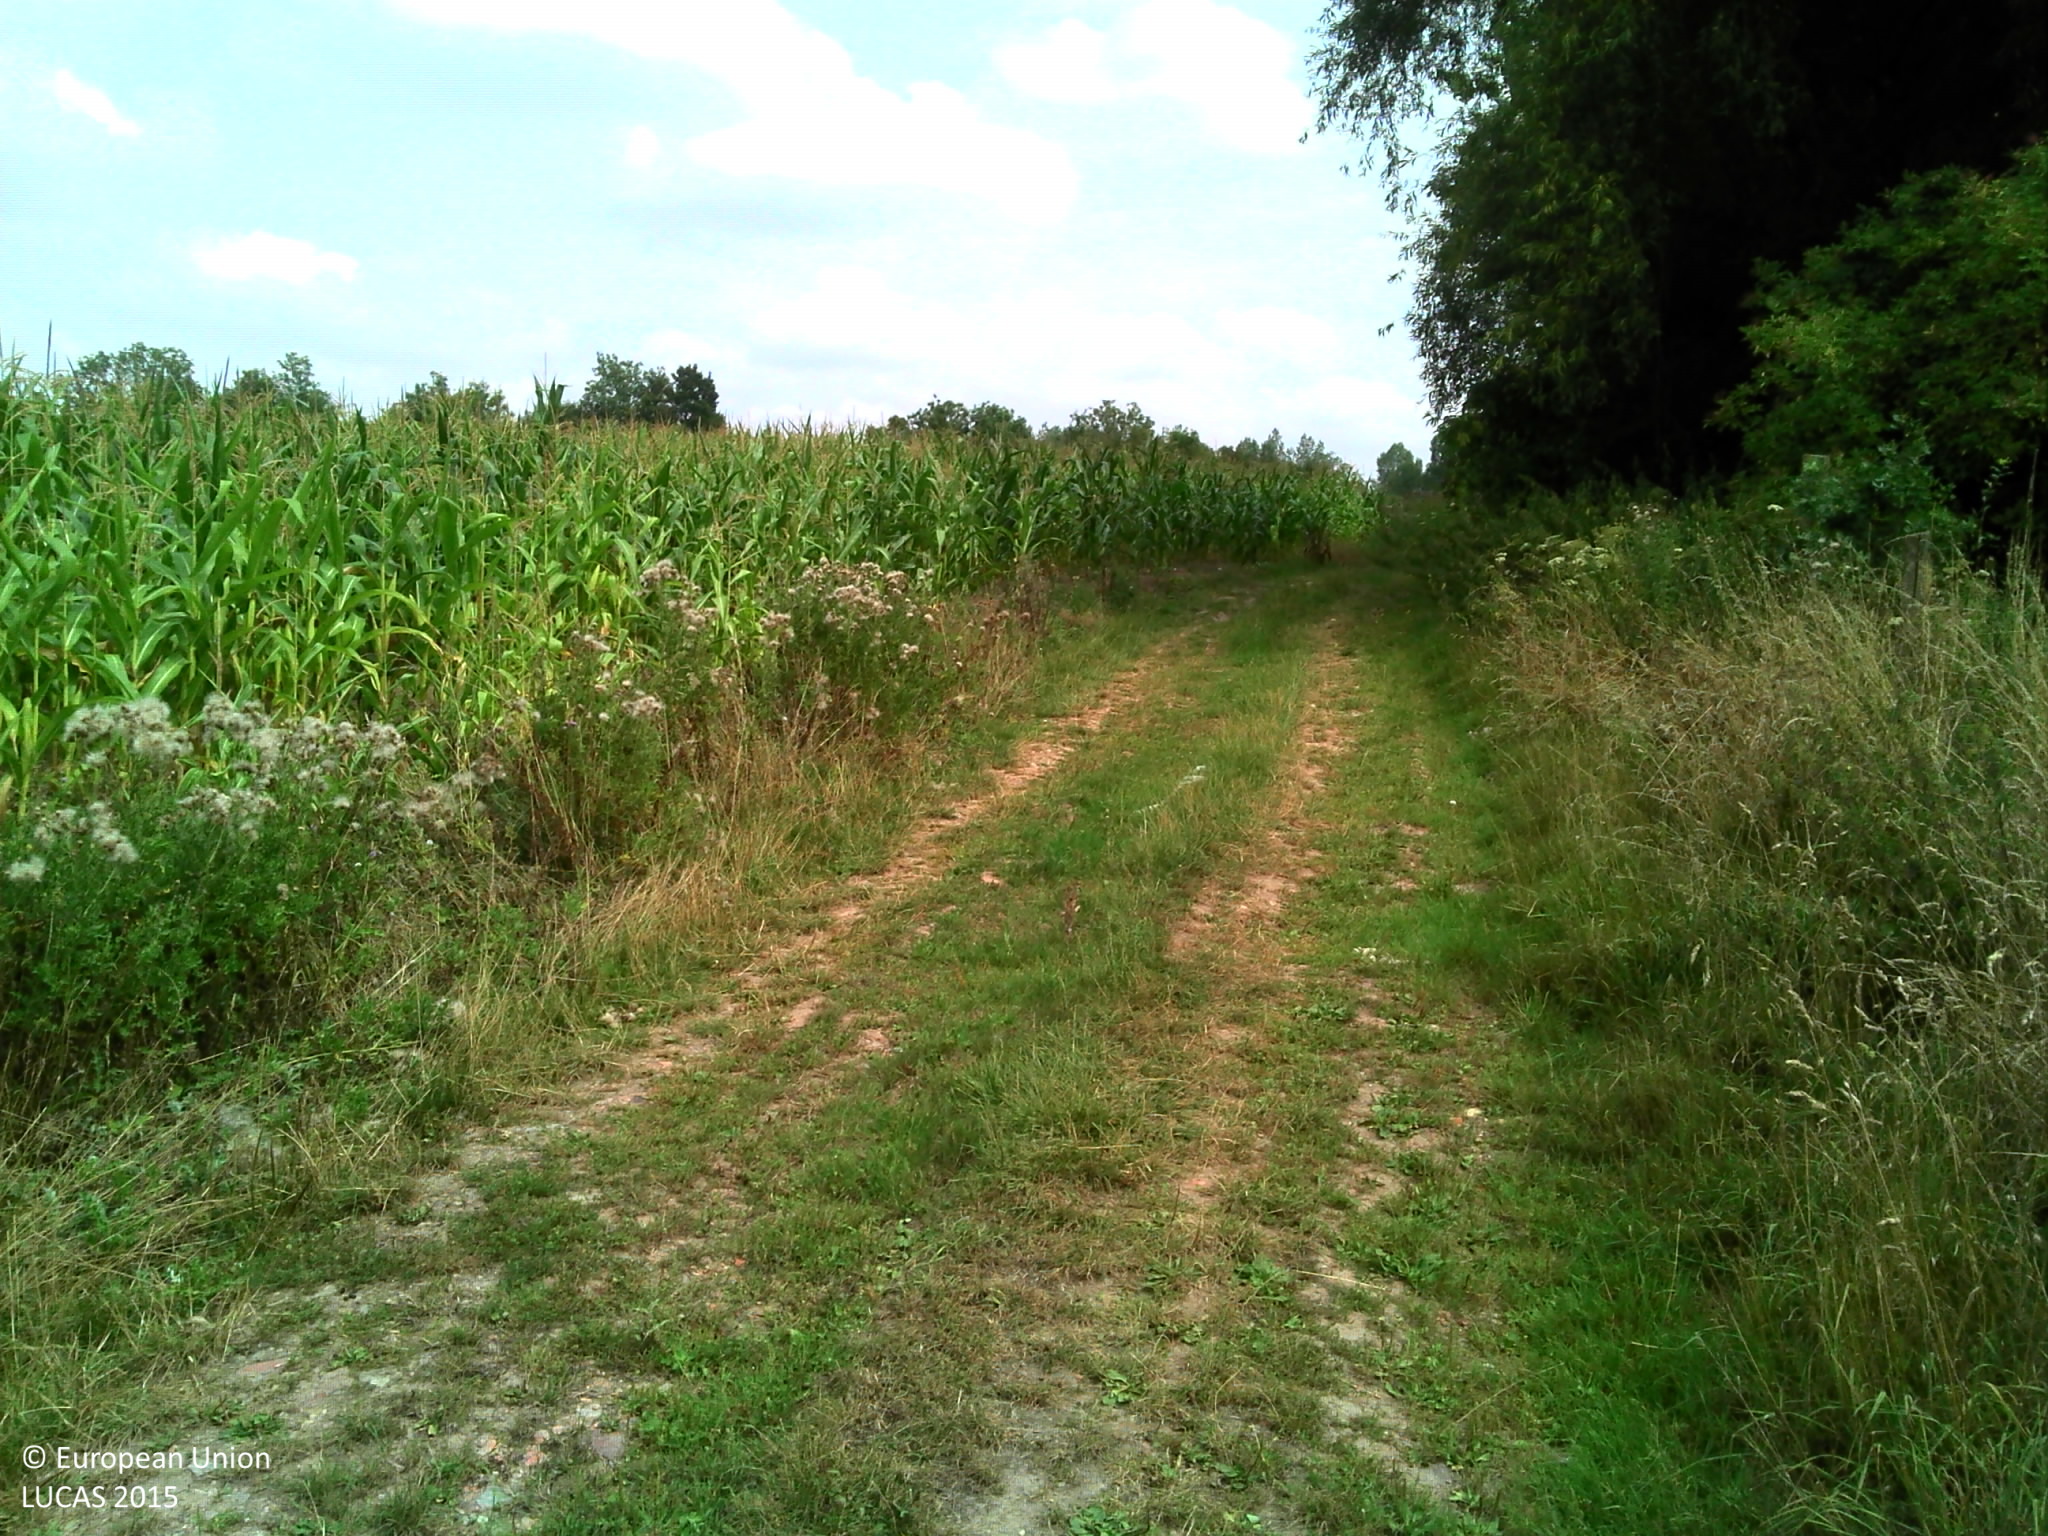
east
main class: Cropland
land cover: Maize
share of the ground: > 75 %
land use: Agriculture (excluding fallow land and kitchen gardens)
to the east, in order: Tracks; Grass margins; Maize; Grass margins; Broadleaved woodland; Grass margins; Paved roads, cycling and walking lanes; Grass margins; Electric lines; Maize
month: August
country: BE
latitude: 50.7067
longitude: 3.5779
